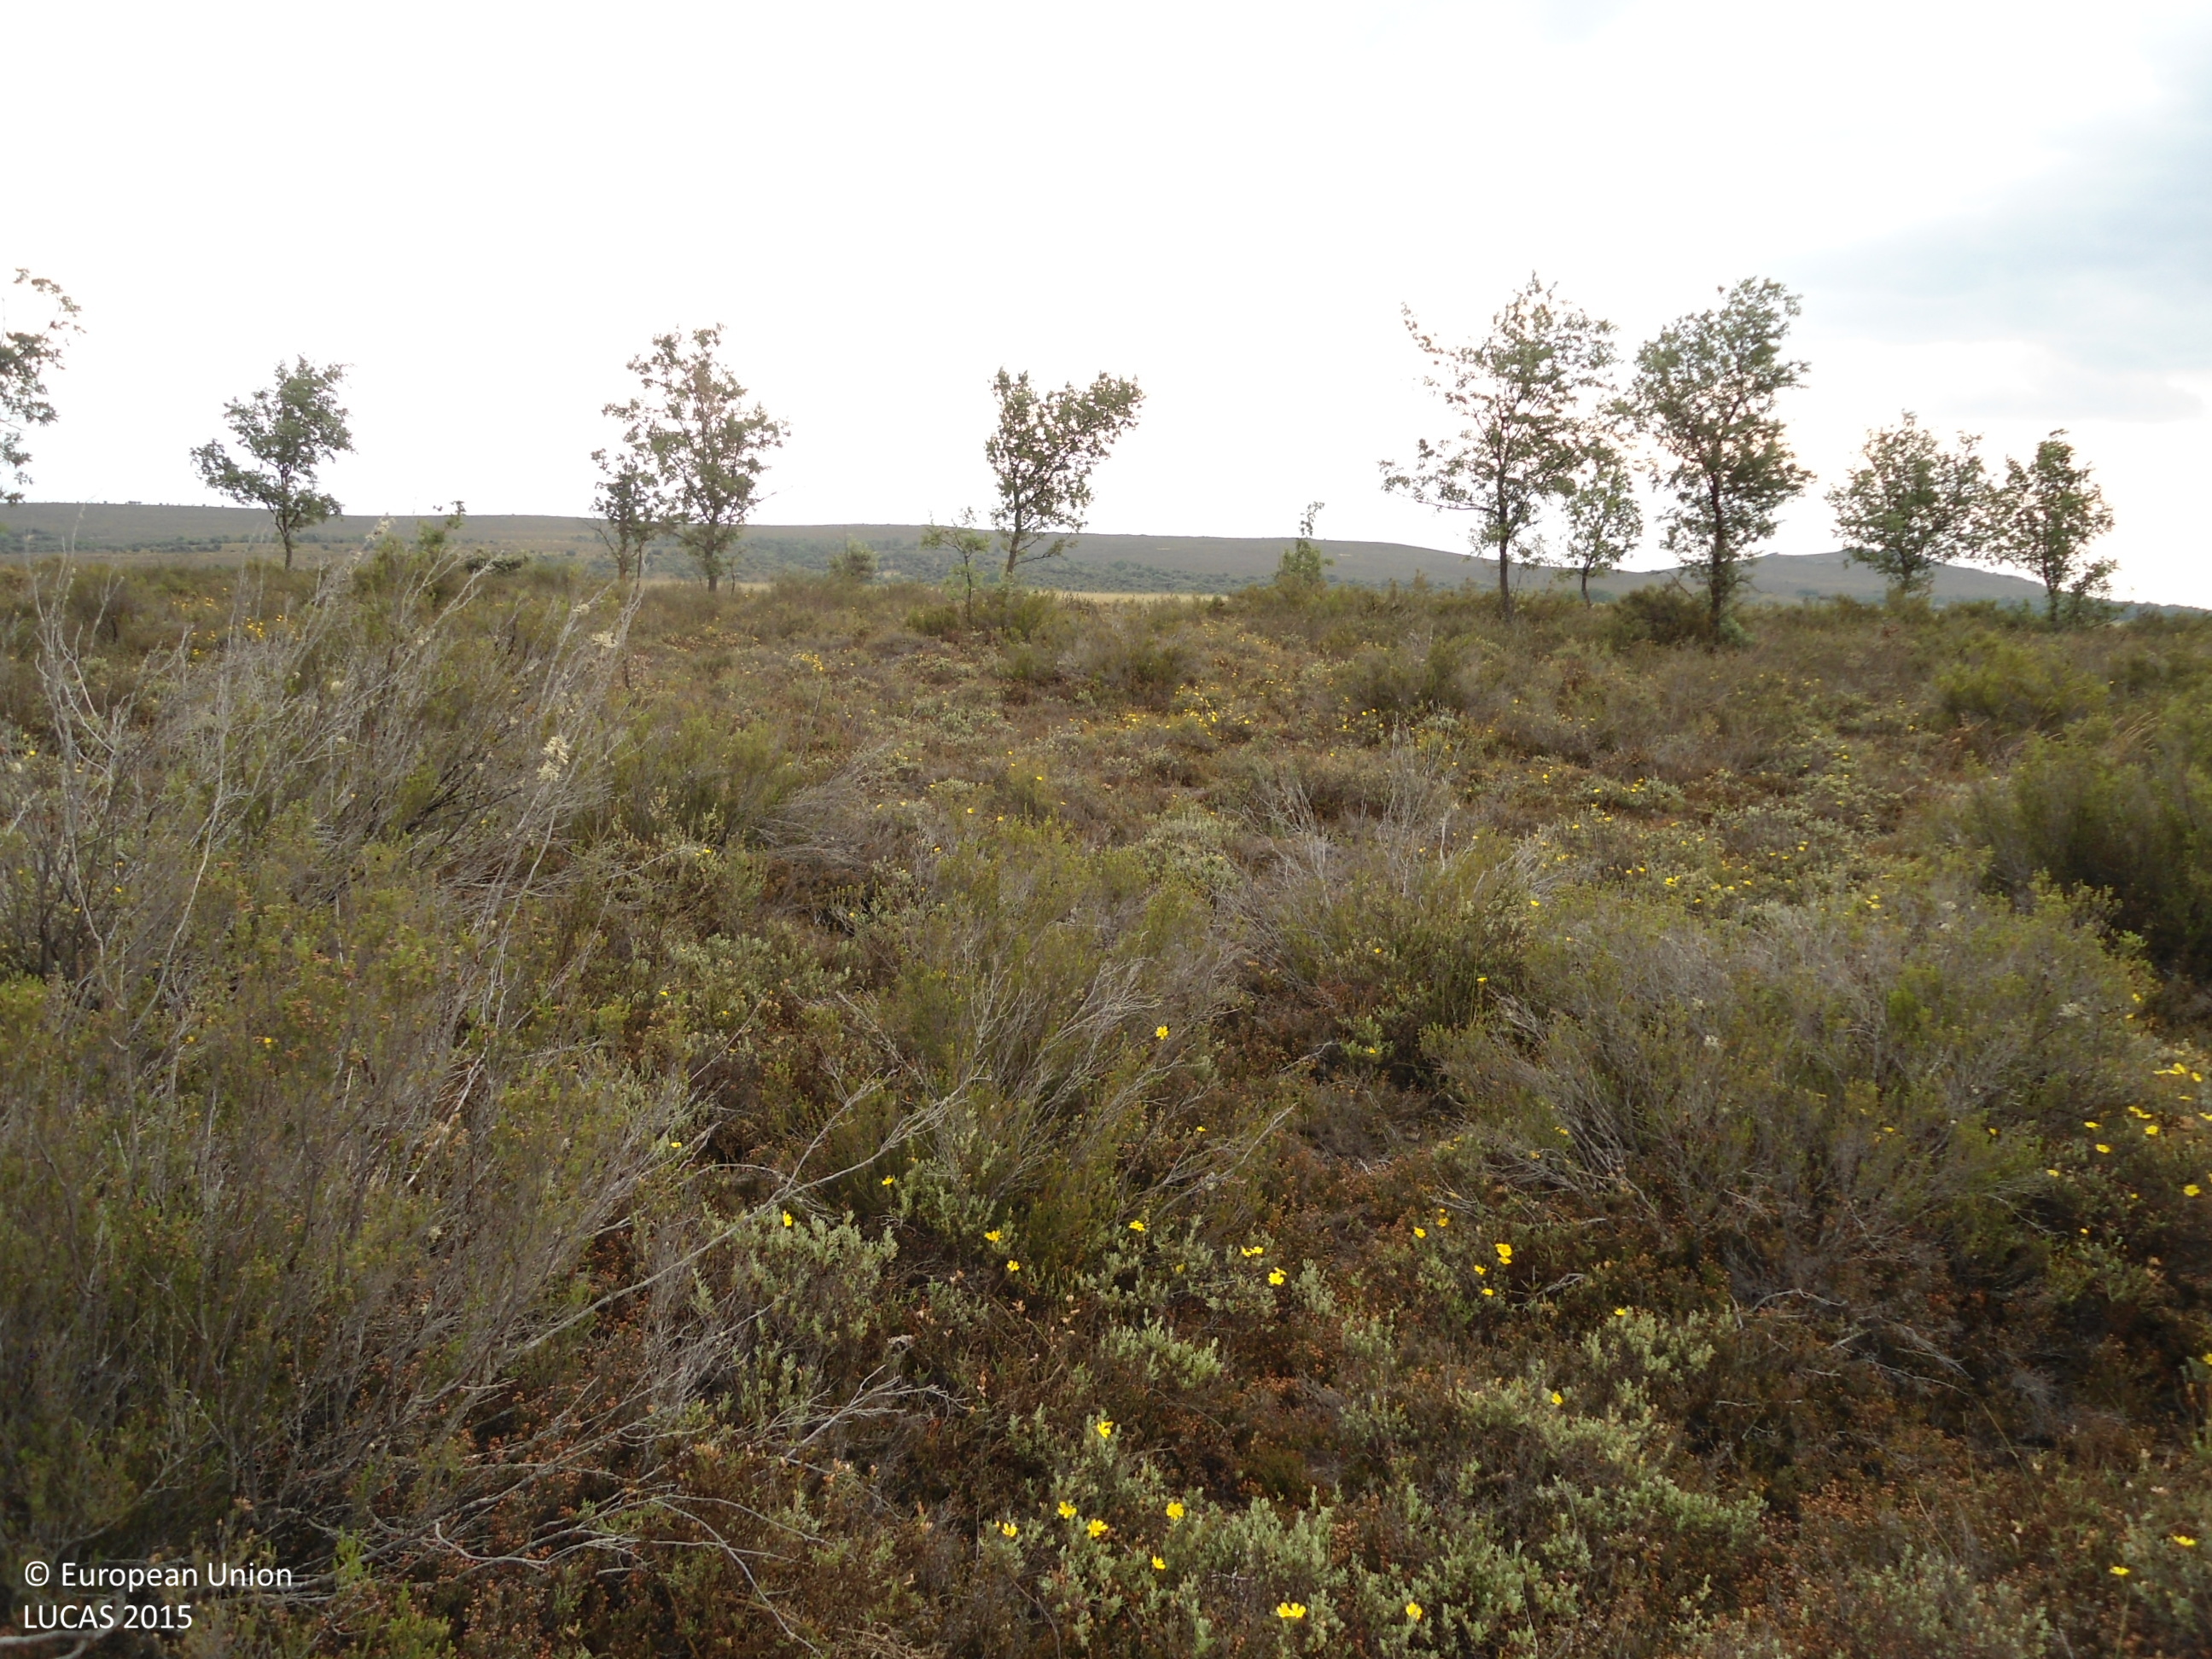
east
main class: Shrubland
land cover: Shrubland with sparse tree cover
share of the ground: > 75 %
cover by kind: shrubs 95 %, broadleaved forest trees 5 %
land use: Semi-natural and natural areas not in use
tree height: < 5 m
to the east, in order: Shrubland with sparse tree cover; Tracks; Shrubland without tree cover; Tracks; Rye; Grassland without tree/shrub cover
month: June
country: ES
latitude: 41.9455
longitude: -6.2058
